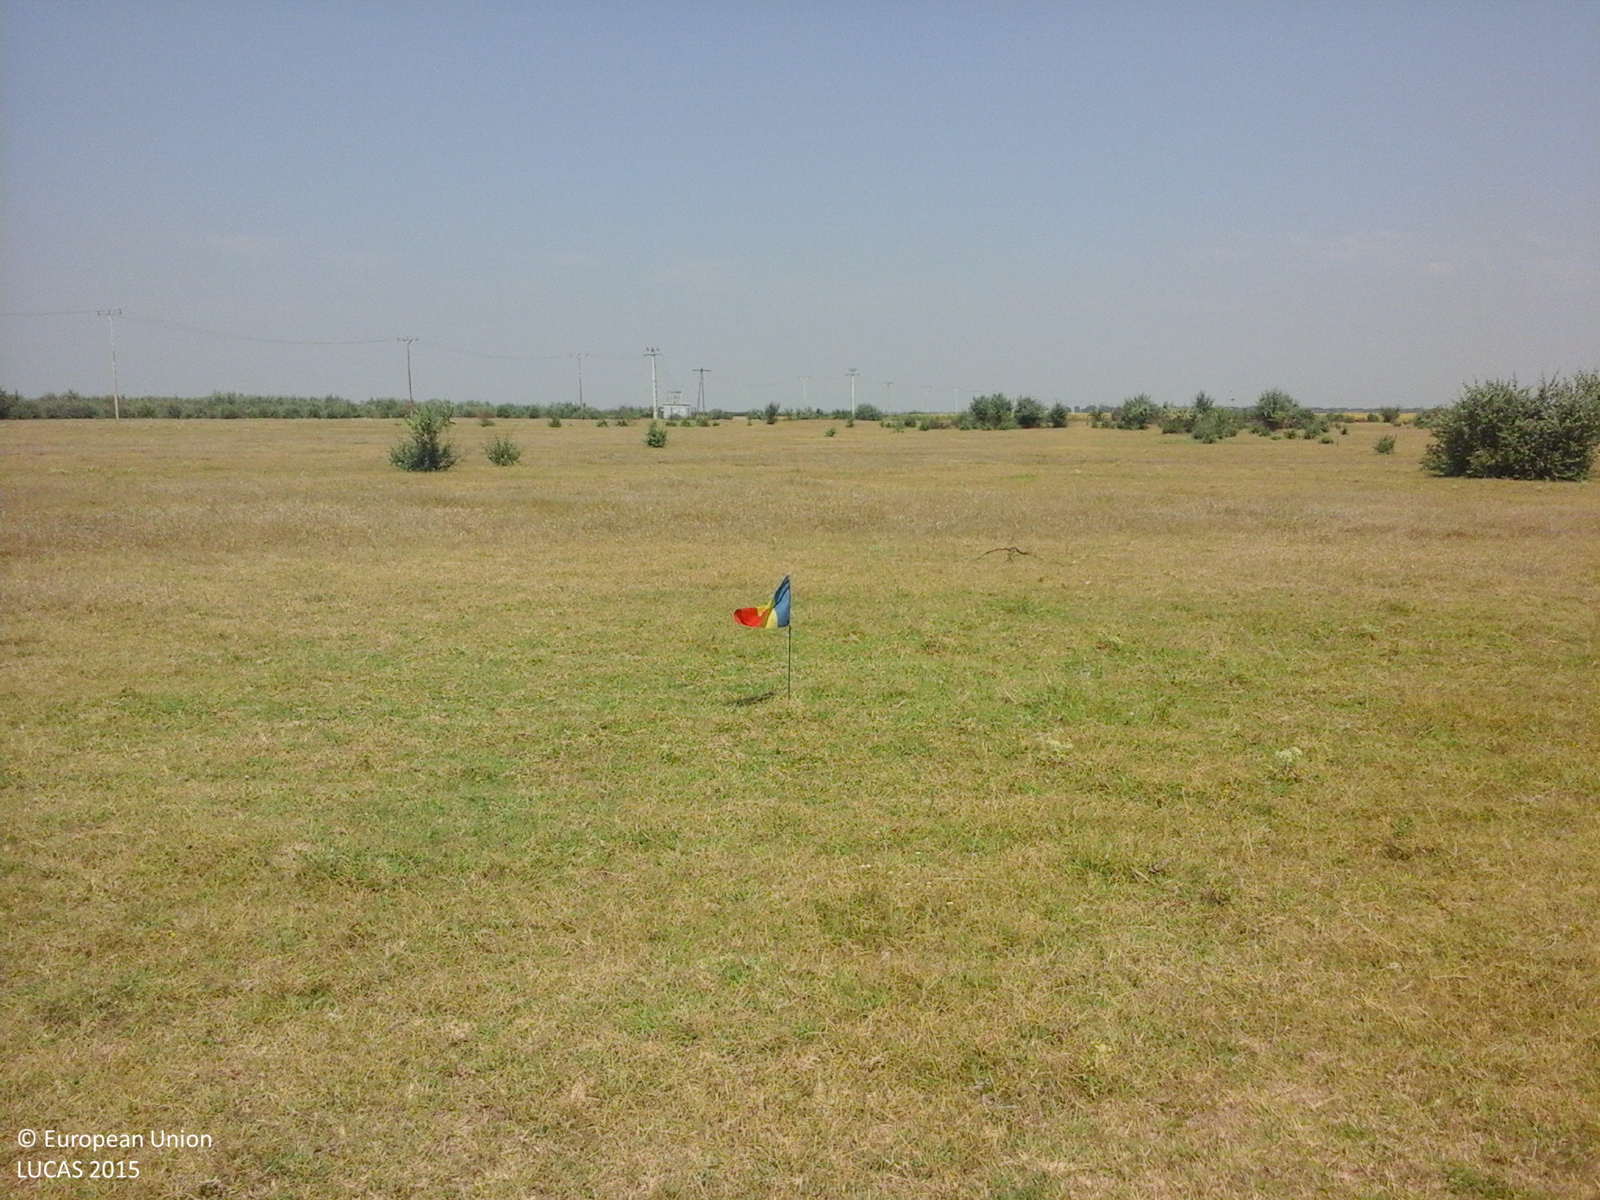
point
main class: Grassland
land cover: Grassland without tree/shrub cover
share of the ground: > 75 %
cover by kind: herbaceous plants 100 %
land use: Agriculture (excluding fallow land and kitchen gardens)
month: August
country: RO
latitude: 45.1266
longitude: 27.3210
